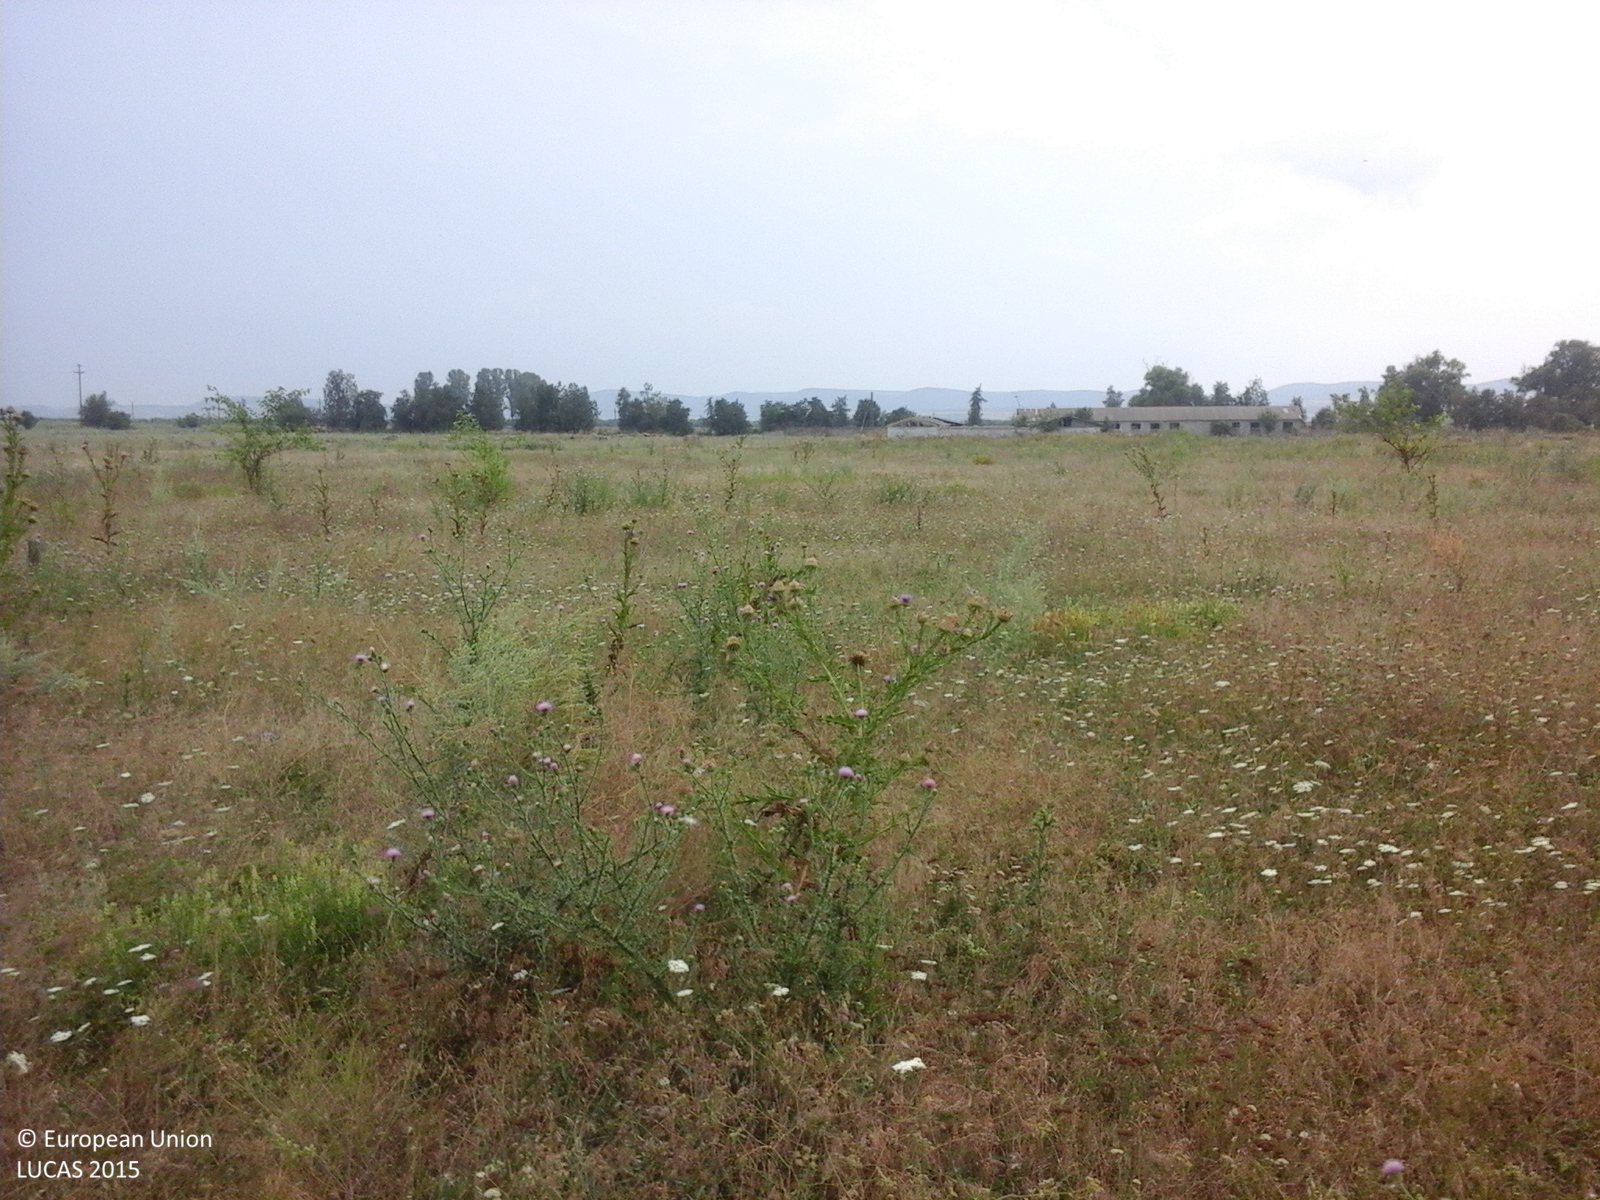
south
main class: Grassland
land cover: Spontaneously vegetated surfaces
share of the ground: > 75 %
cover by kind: herbaceous plants 100 %
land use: Fallow land
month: July
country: RO
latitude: 44.9451
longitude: 28.7808
